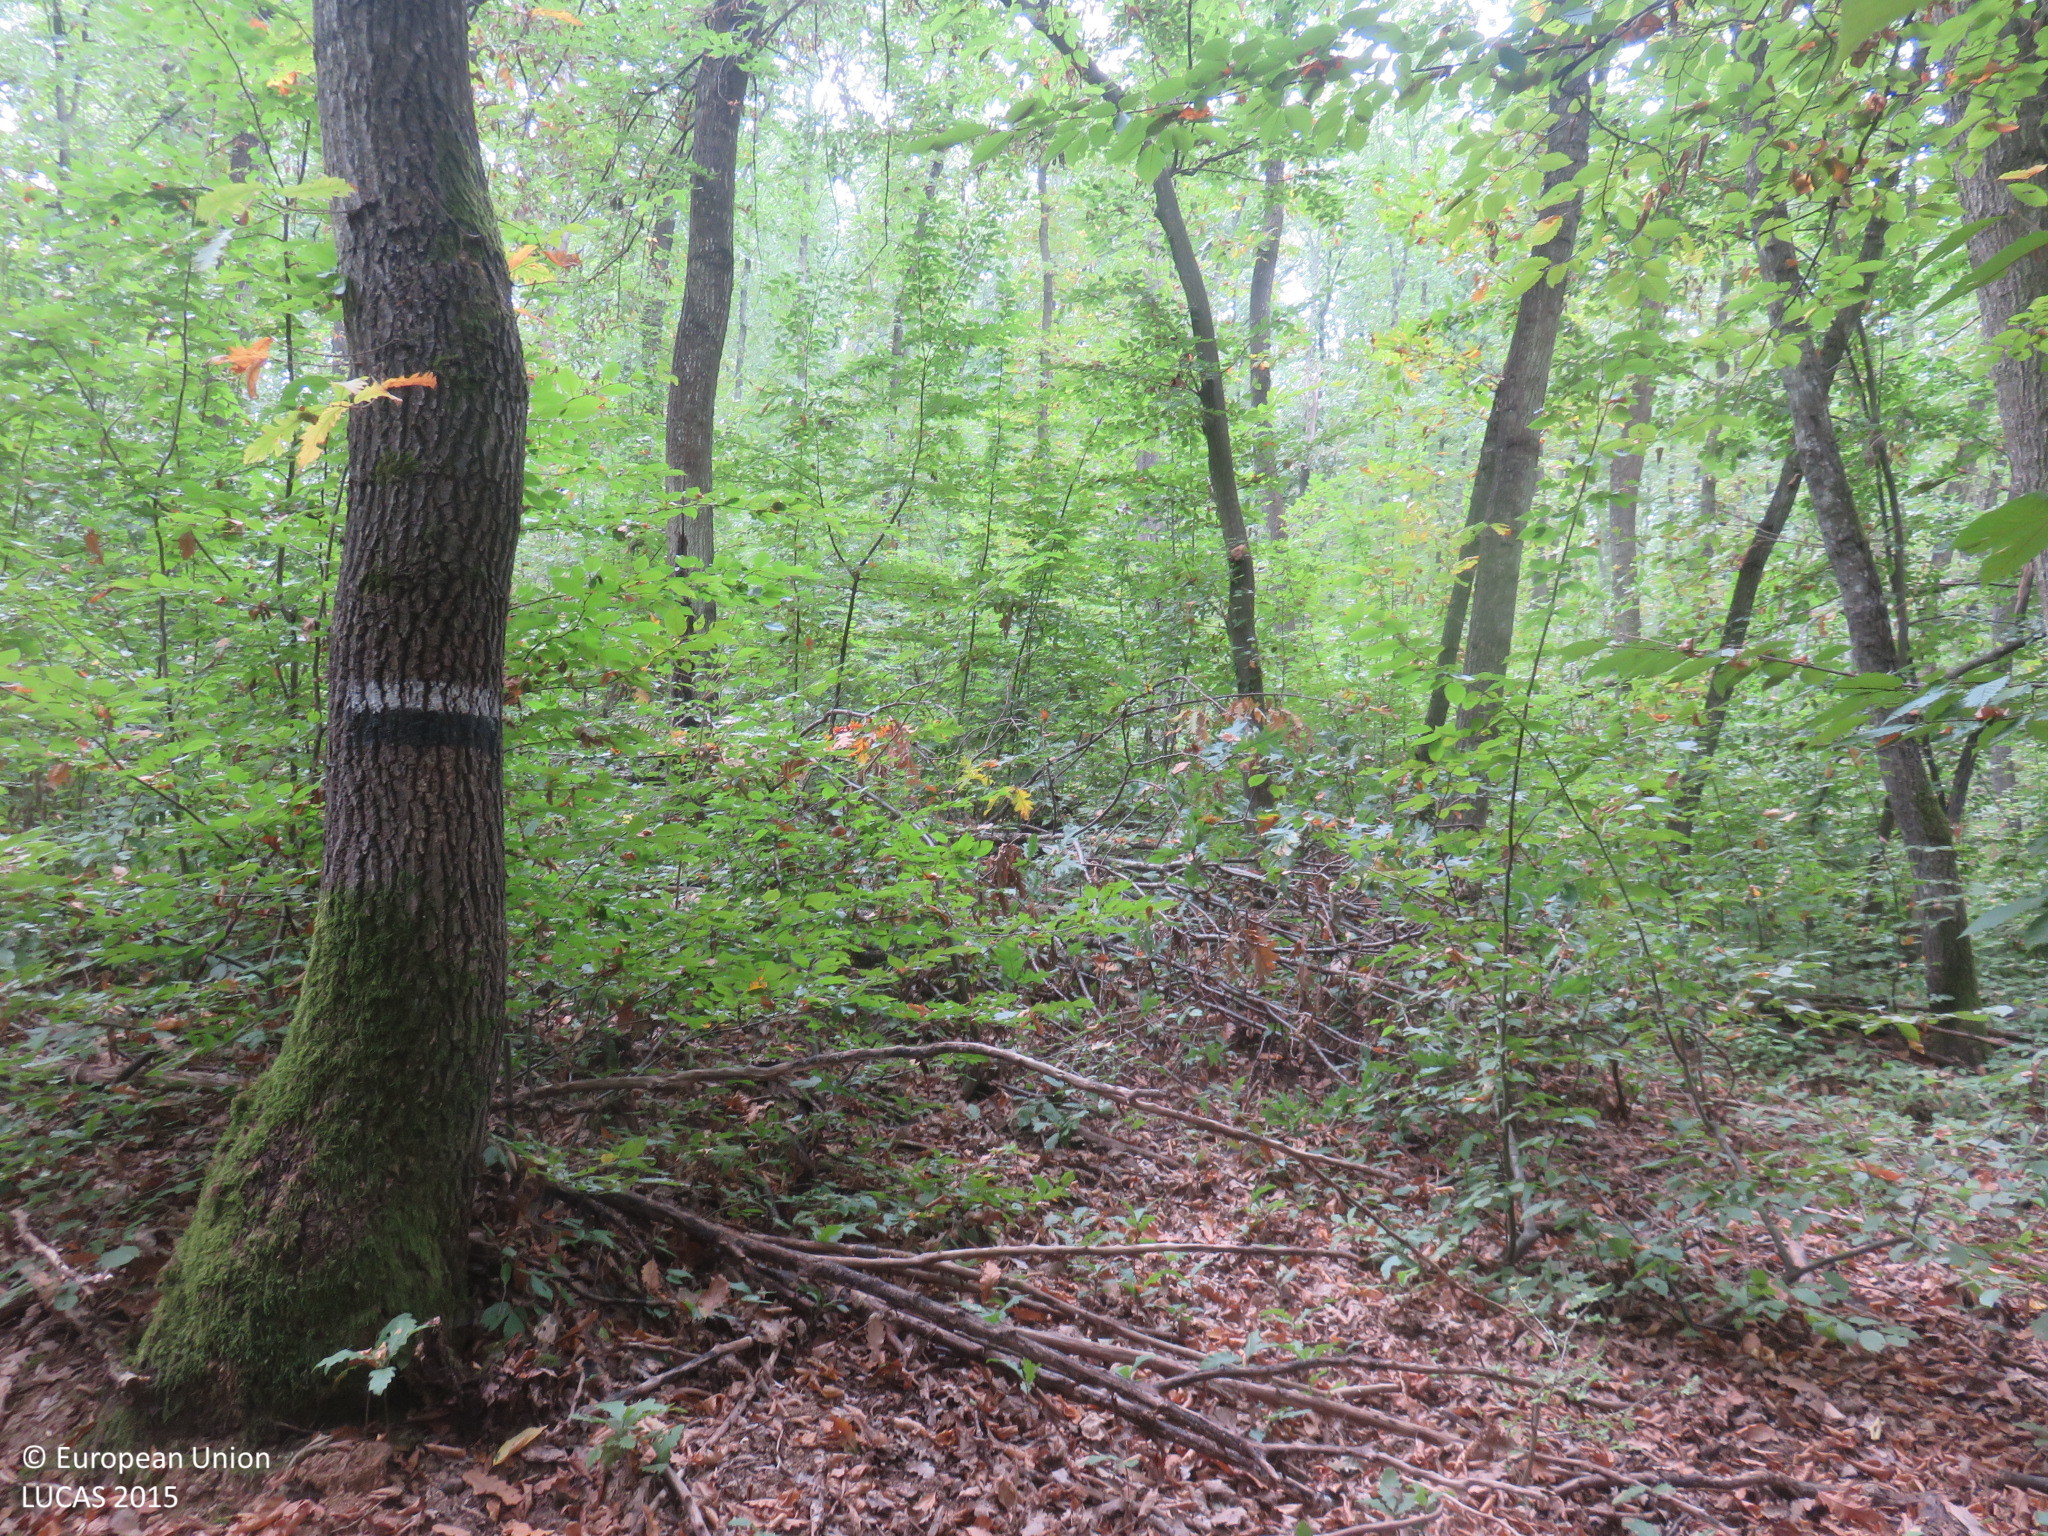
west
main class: Woodland
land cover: Broadleaved woodland
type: beech forest
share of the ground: > 75 %
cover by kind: broadleaved forest trees 85 %, unconsolidated bare surface 10 %, shrubs 5 %
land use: Forestry
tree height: > 5 m
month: September
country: BG
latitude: 43.0929
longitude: 24.8430
